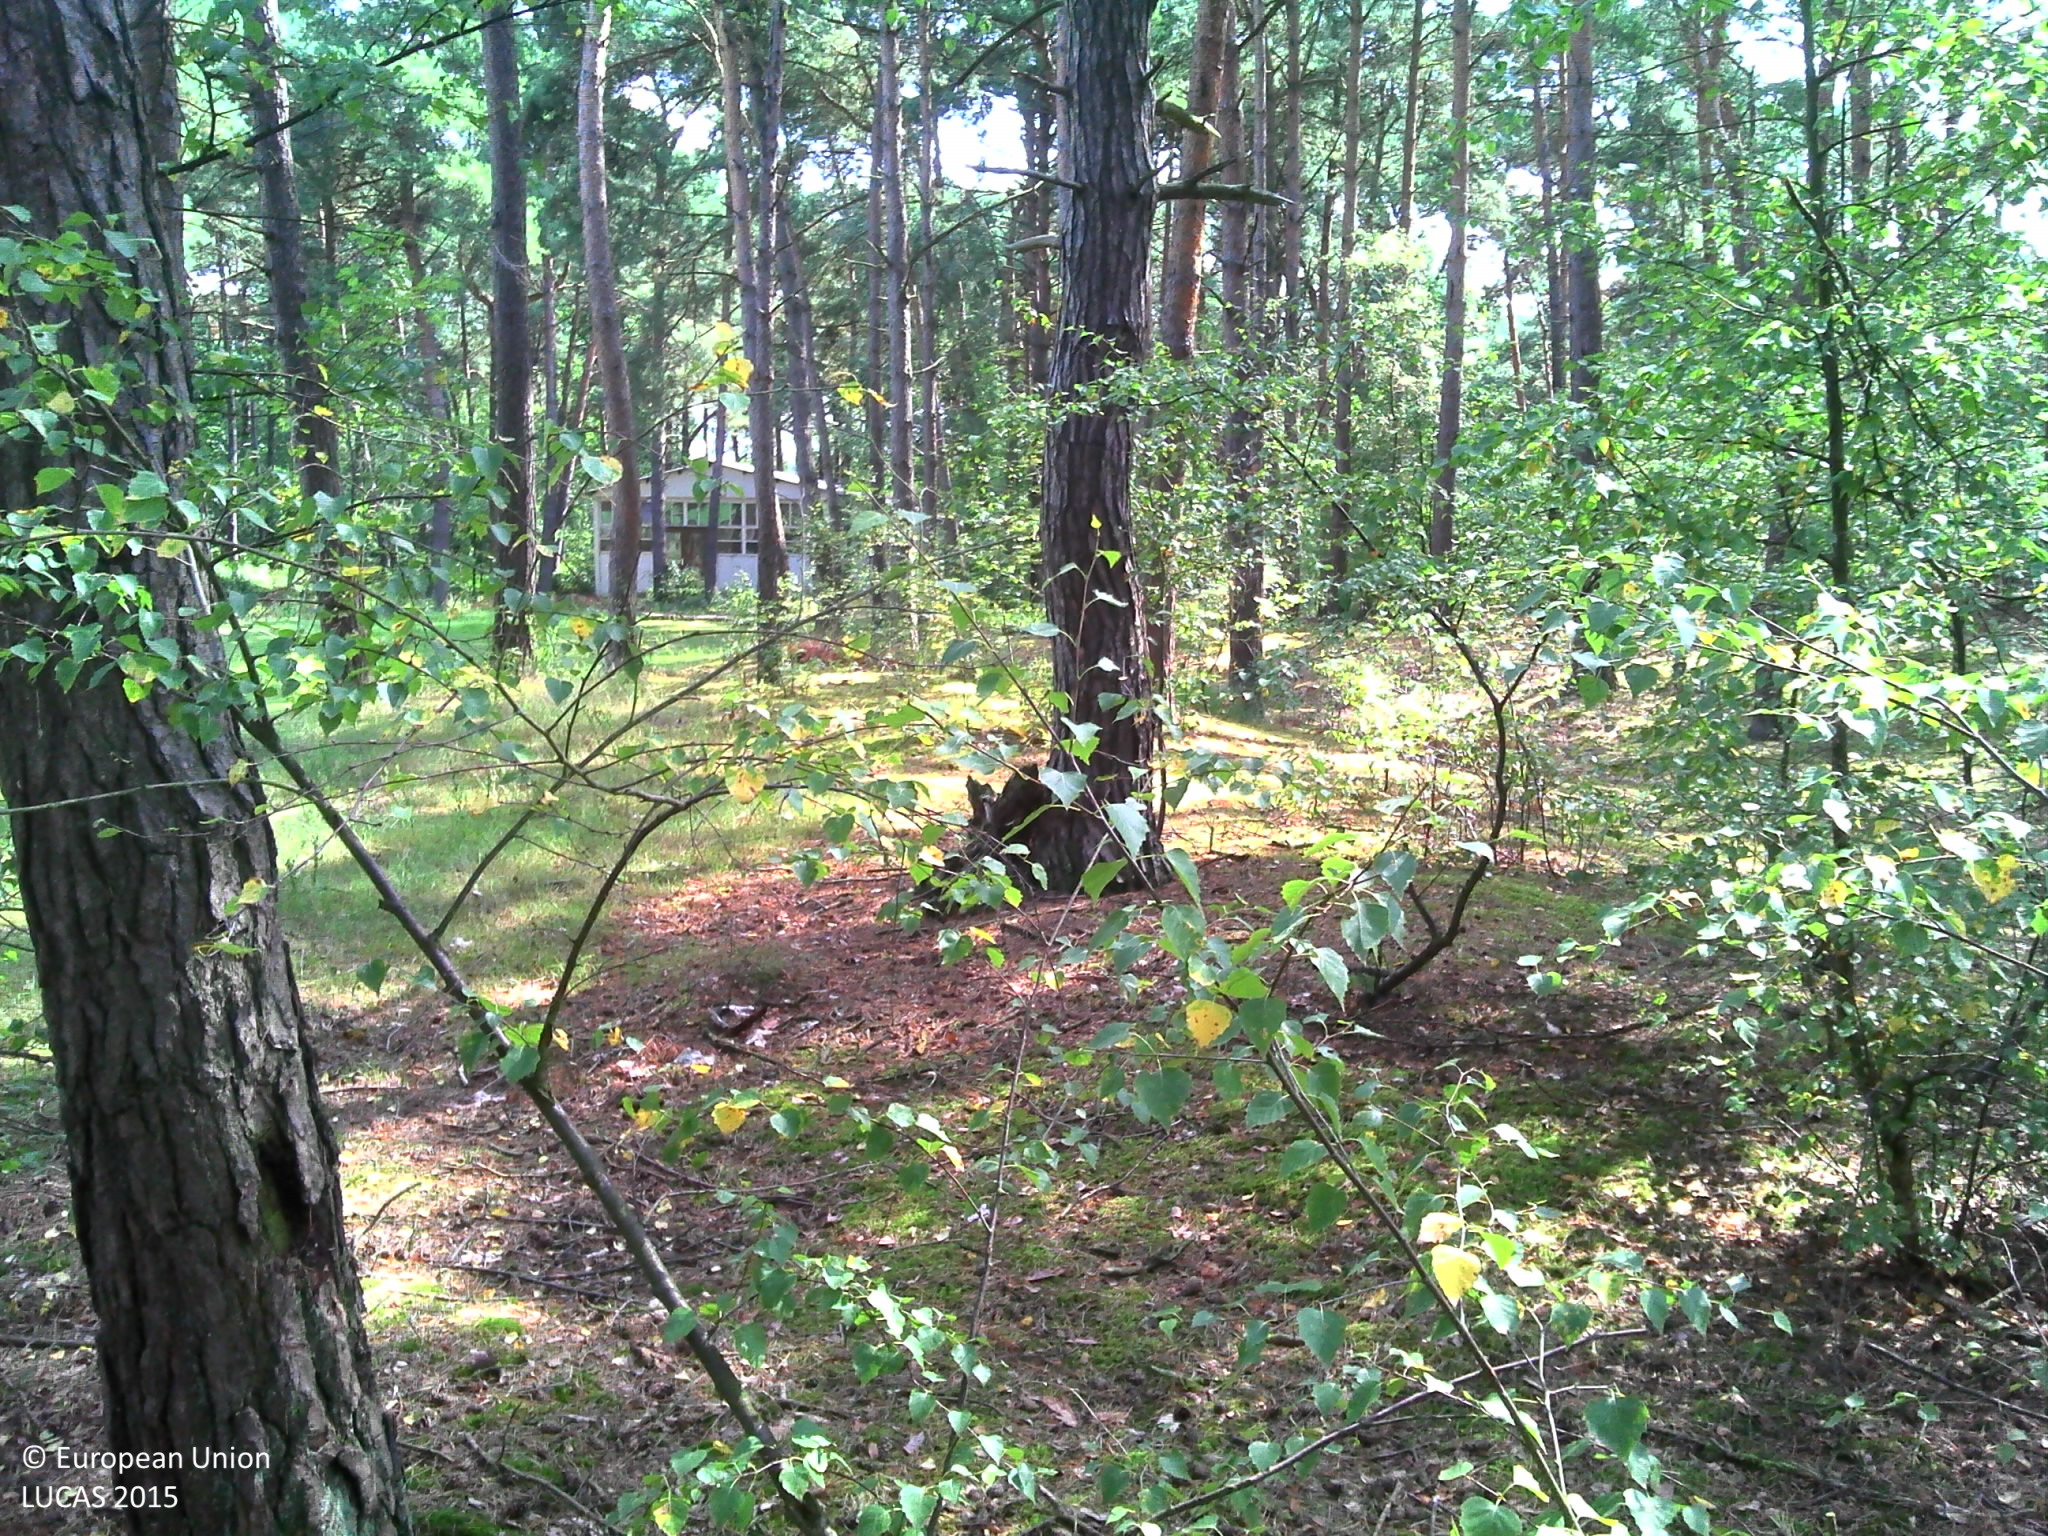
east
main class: Woodland
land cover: Pine dominated coniferous woodland
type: exotic forest
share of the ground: > 75 %
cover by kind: coniferous forest trees 90 %, broadleaved forest trees 5 %, lichens and mosses 5 %
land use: Amenities, museums, leisure
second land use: Residential
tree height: > 5 m
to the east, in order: Pine dominated coniferous woodland; Artificial constructions in urban areas; Pine dominated coniferous woodland; Pine dominated mixed woodland; Ditches and canals; Tracks; Fences; Abandoned hedges; Tracks; Spontaneously vegetated surfaces; Inland marshes; Spontaneously vegetated surfaces; Inland marshes; Broadleaved woodland
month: August
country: BE
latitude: 51.2168
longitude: 5.1727
